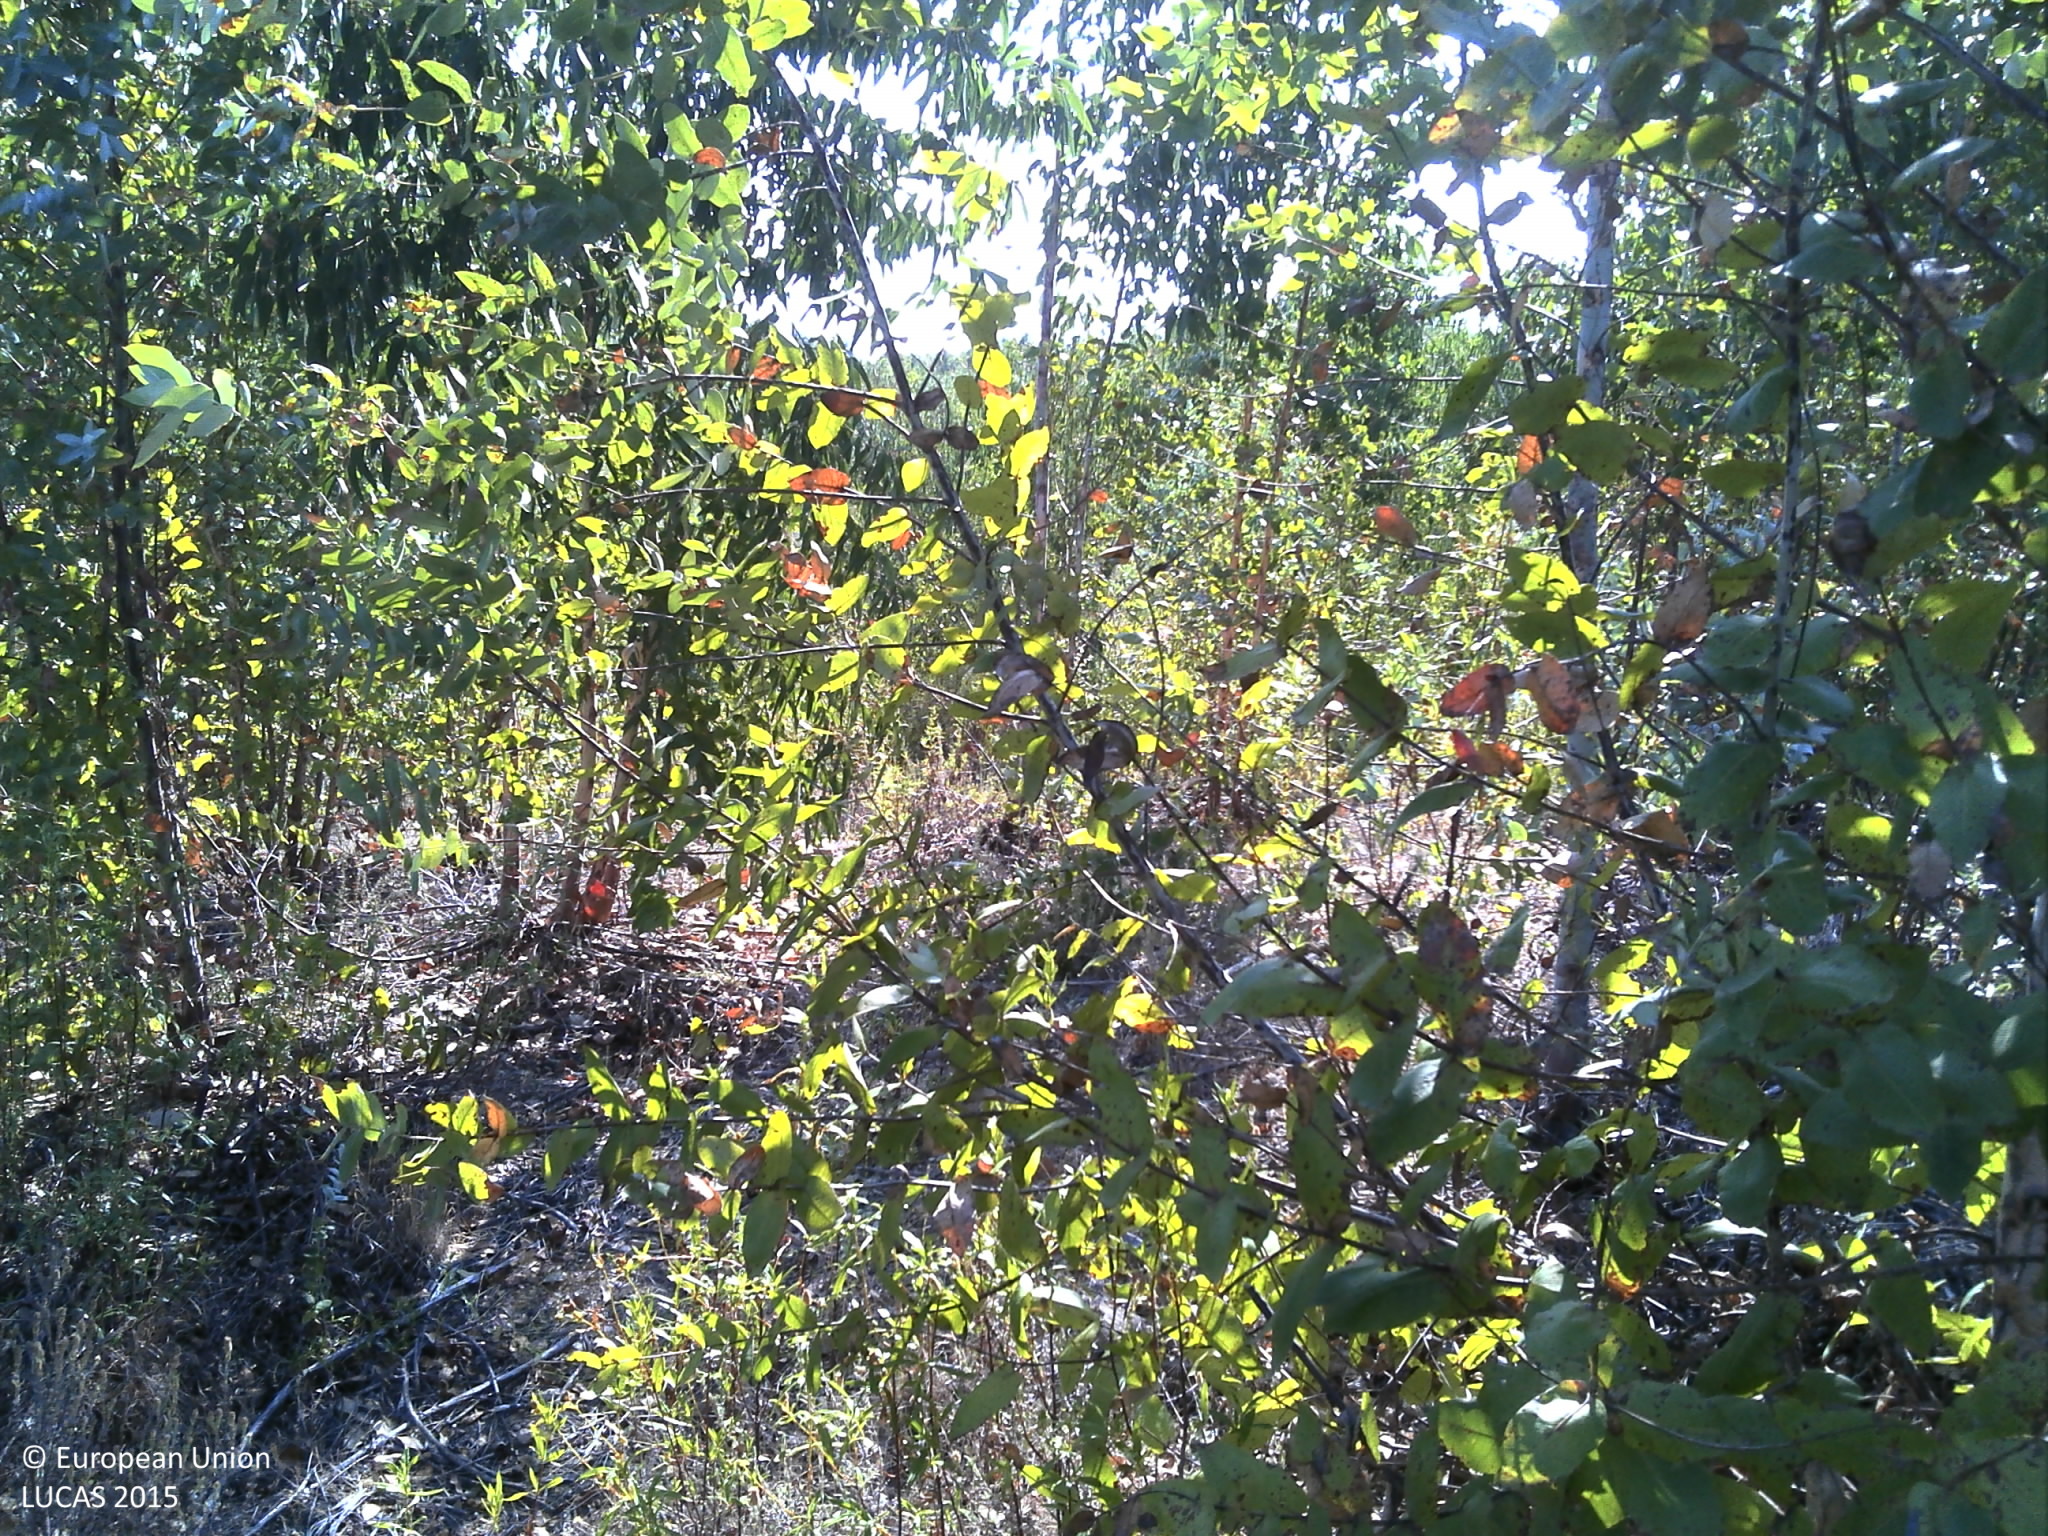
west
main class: Woodland
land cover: Broadleaved woodland
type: exotic forest
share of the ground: 10 - 25 %
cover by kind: shrubs 70 %, broadleaved forest trees 15 %, unconsolidated bare surface 15 %
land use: Forestry
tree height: > 5 m
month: July
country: PT
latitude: 39.6135
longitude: -7.7480
